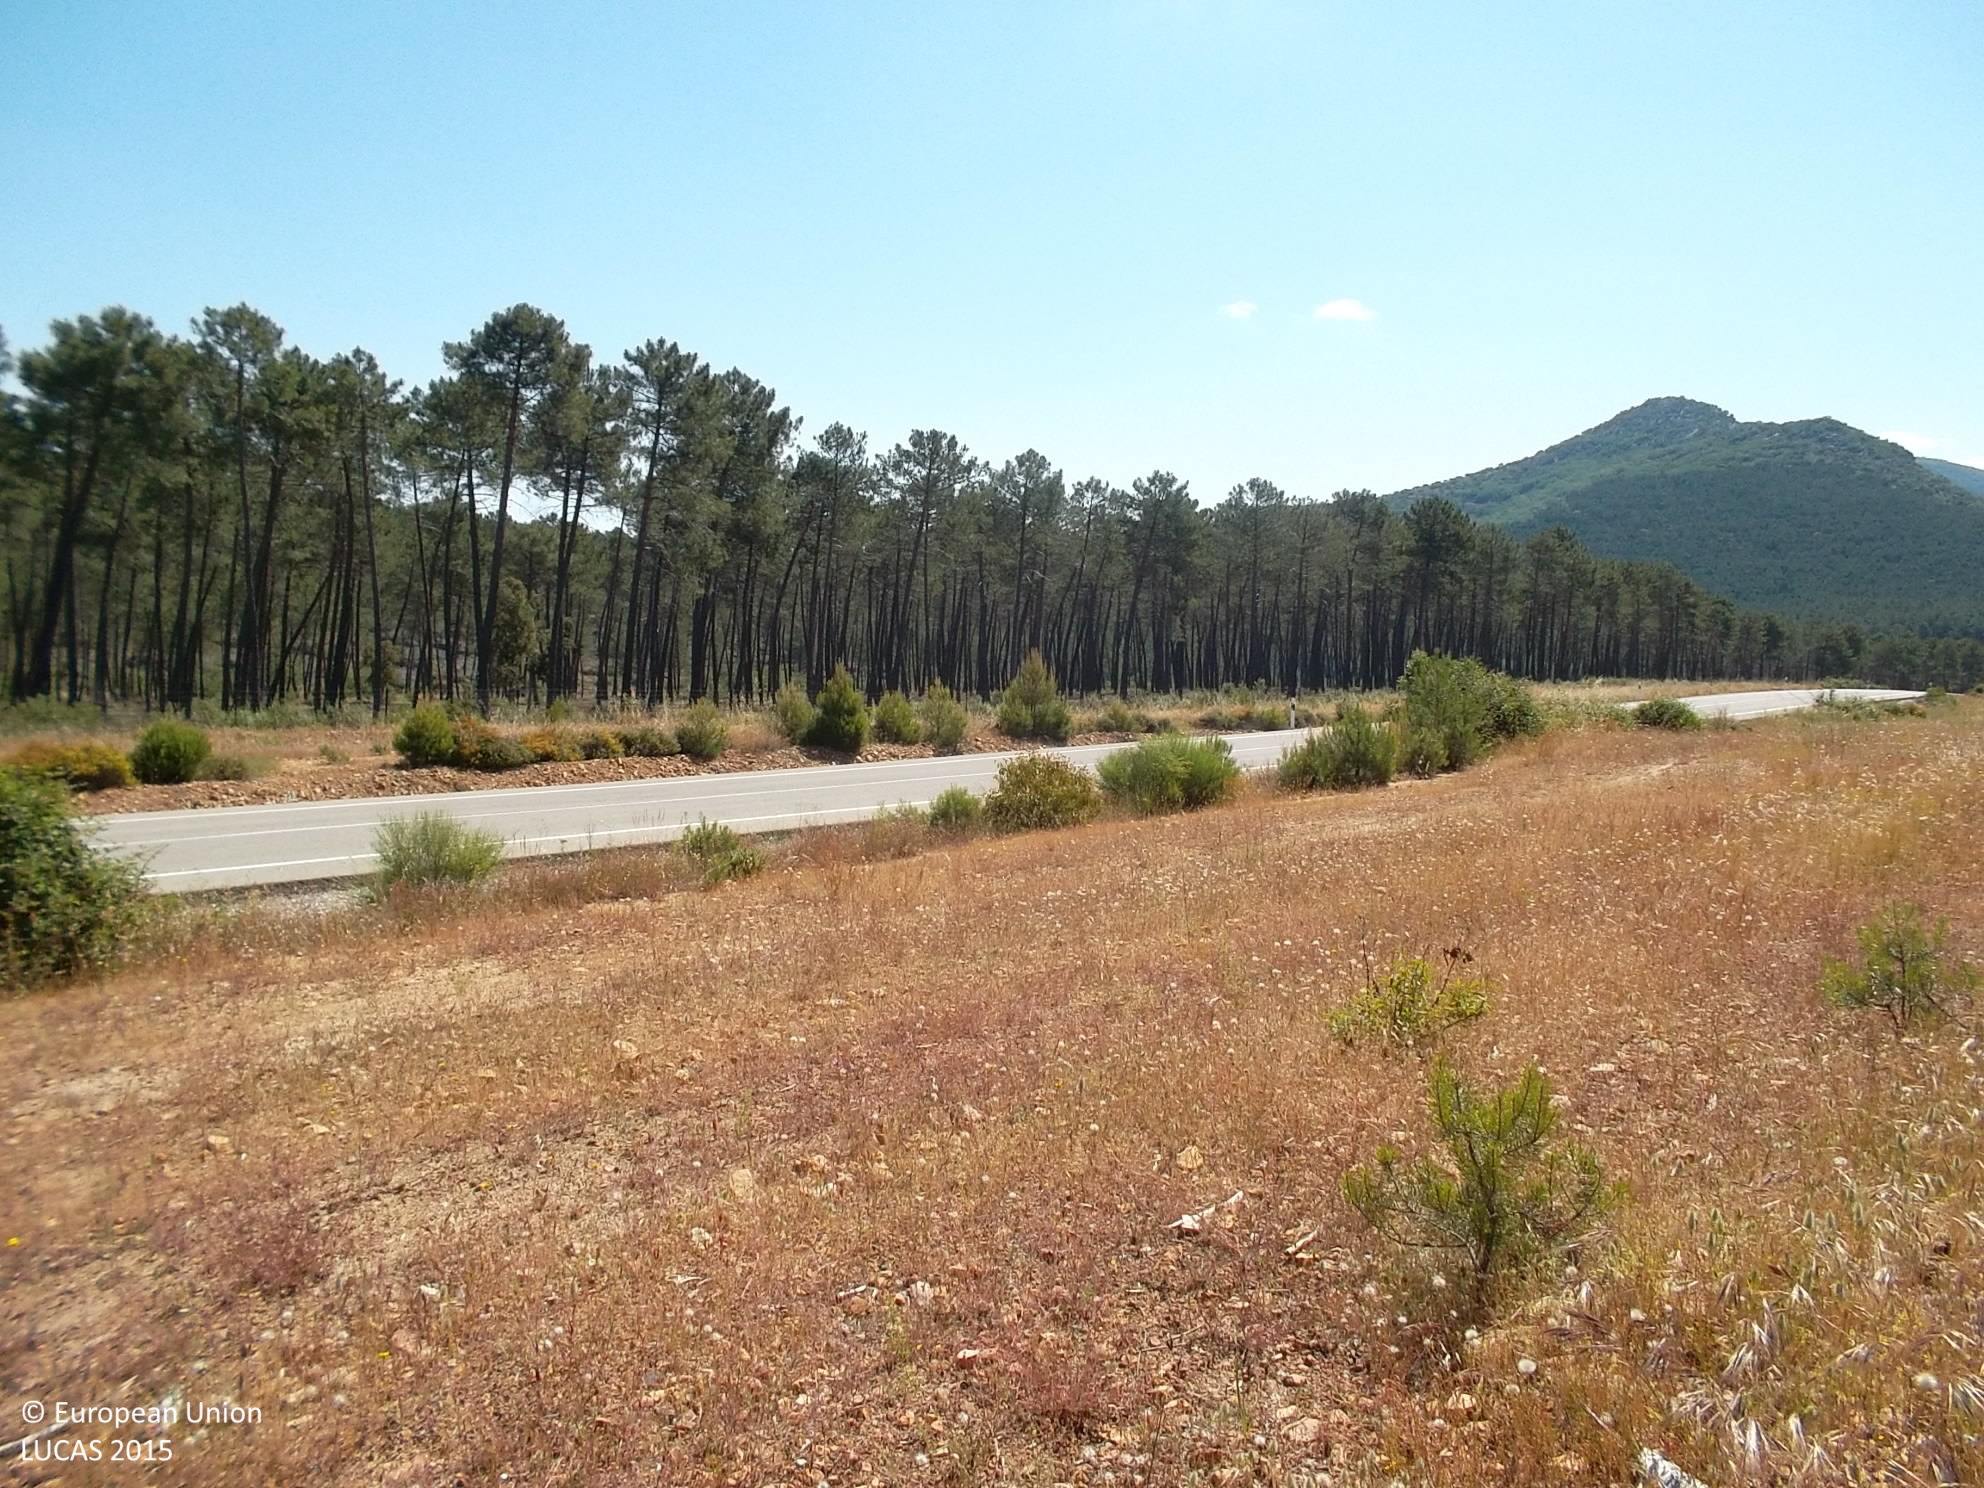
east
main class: Grassland
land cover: Grassland without tree/shrub cover
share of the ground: 50 - 75 %
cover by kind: herbaceous plants 75 %, unconsolidated bare surface 20 %, shrubs 5 %
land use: Protection infrastructures
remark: Fire break
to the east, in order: Grassland without tree/shrub cover; Shruby margins; Paved roads, cycling and walking lanes; Shruby margins; Grassland without tree/shrub cover; Shruby margins; Fences; Pine dominated coniferous woodland
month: May
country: ES
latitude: 38.4711
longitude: -4.3569
